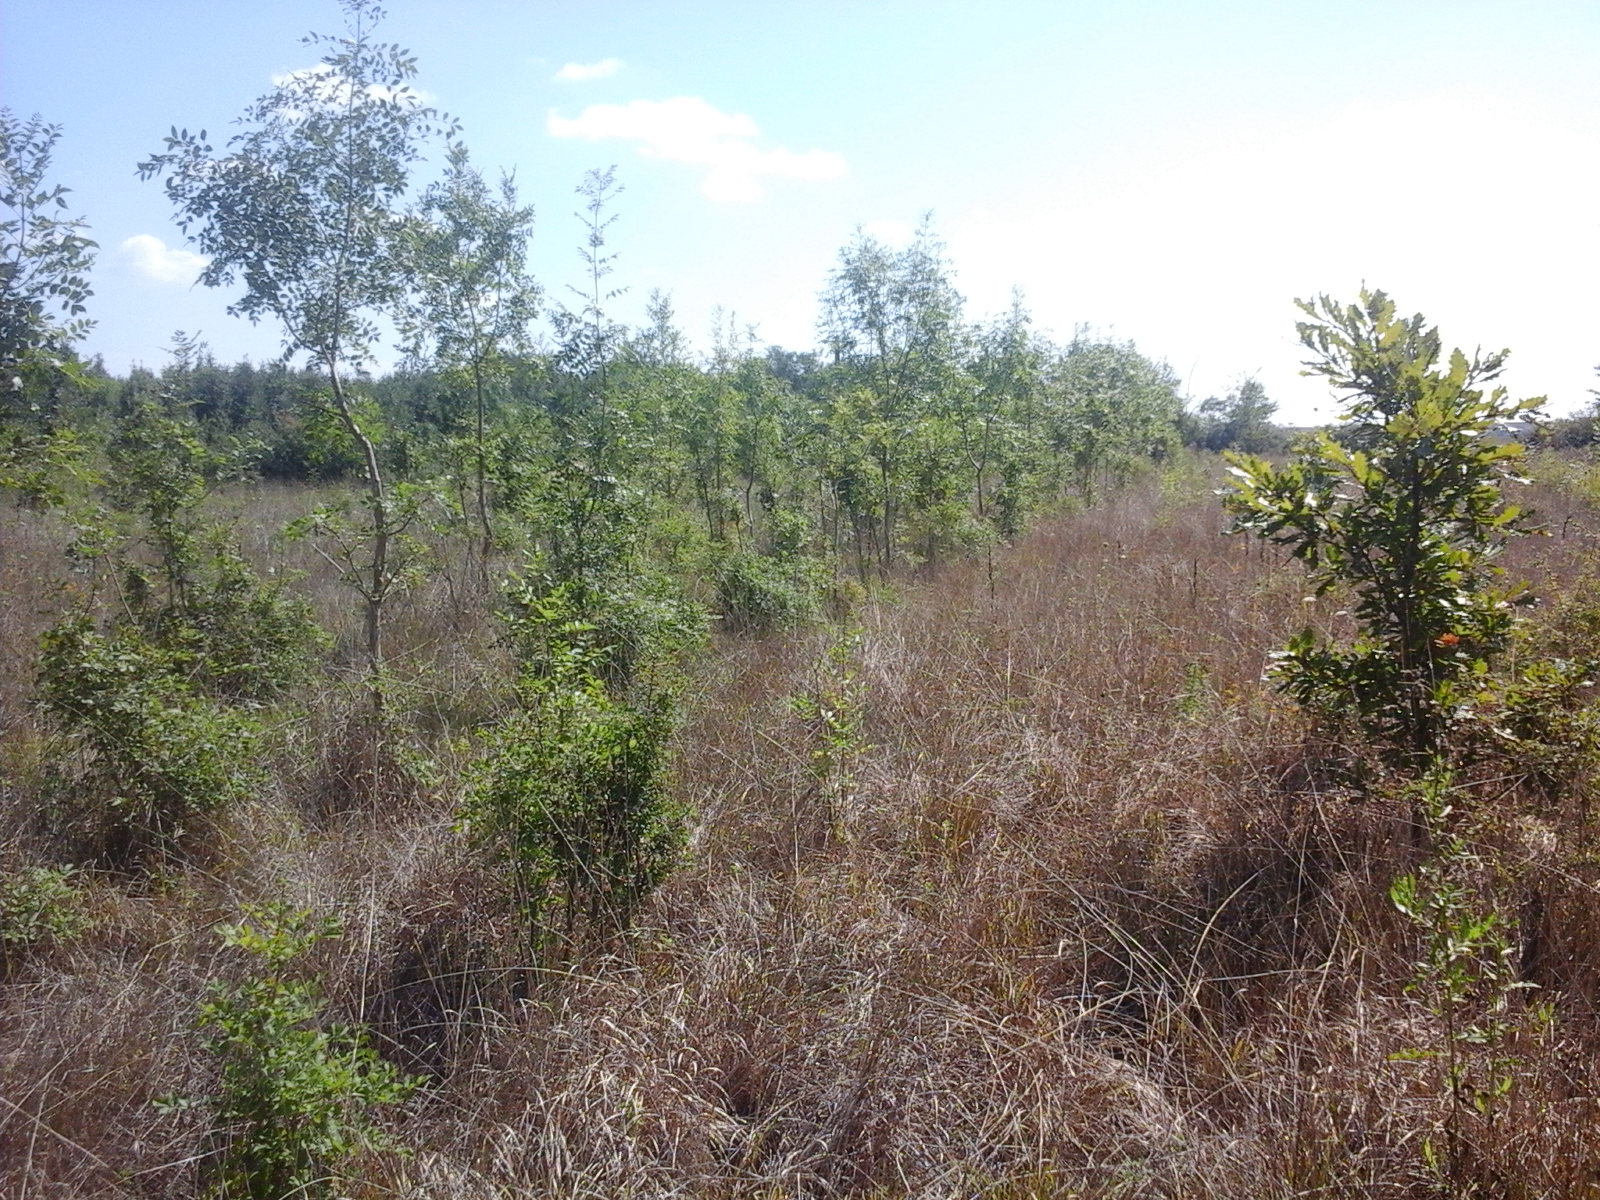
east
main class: Grassland
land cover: Grassland with sparse tree/shrub cover
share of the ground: > 75 %
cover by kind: herbaceous plants 95 %, broadleaved forest trees 5 %
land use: Fallow land
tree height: > 5 m
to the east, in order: Grassland with sparse tree/shrub cover; Broadleaved woodland
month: August
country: RO
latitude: 46.1201
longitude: 21.0689
